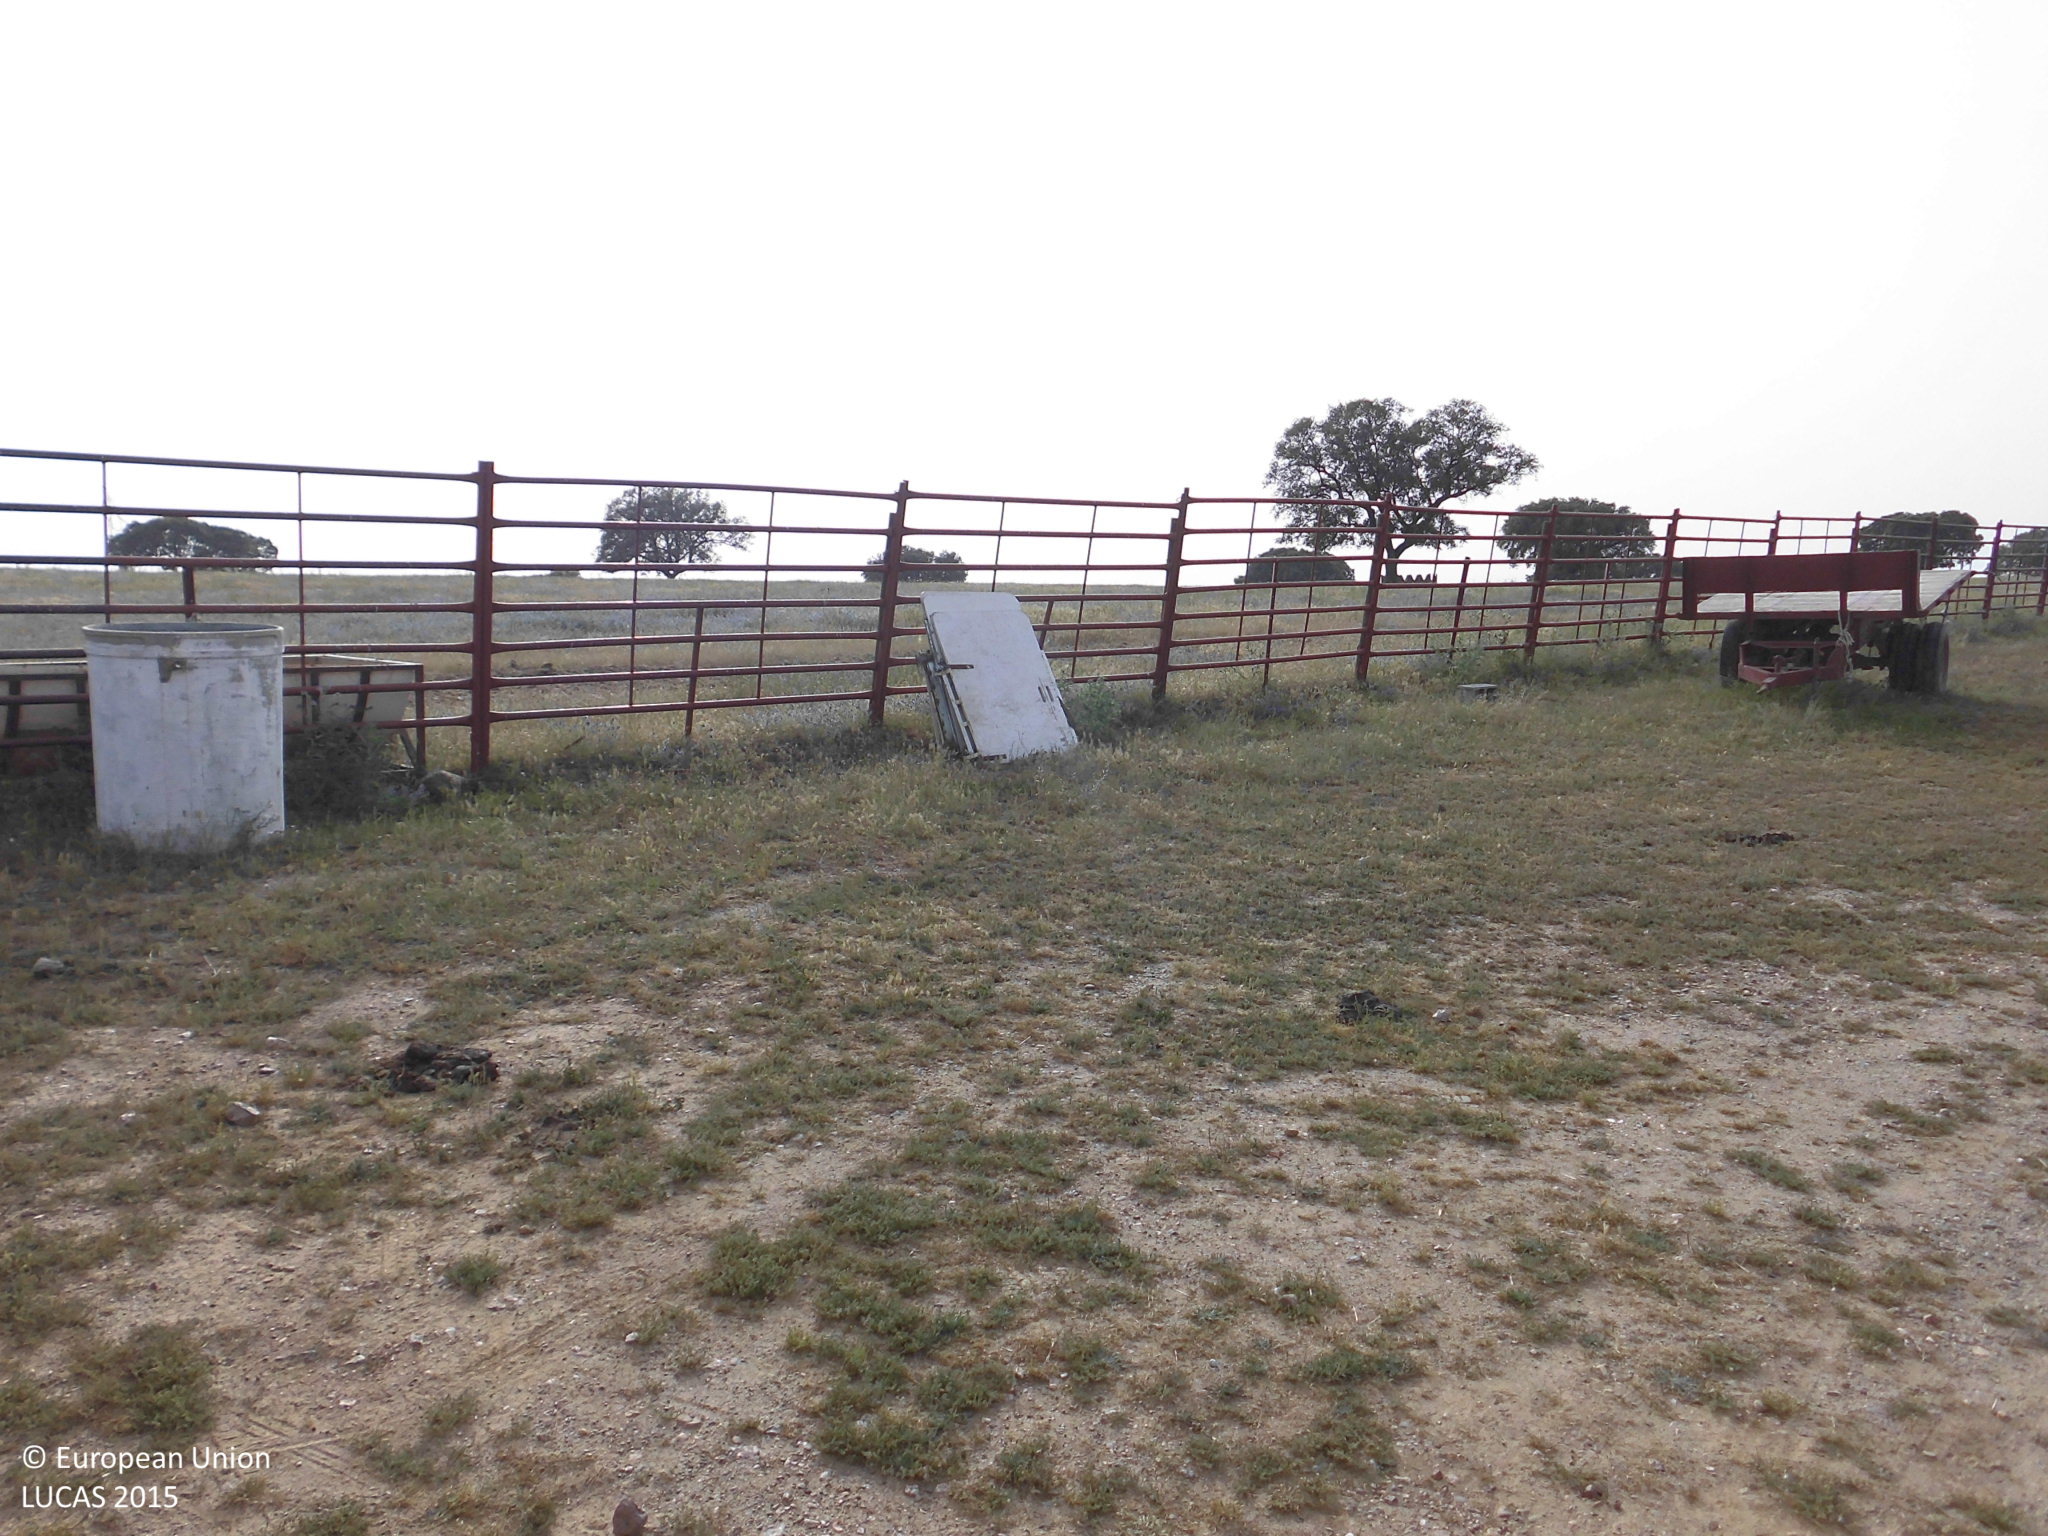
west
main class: Woodland
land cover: Broadleaved woodland
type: broadleaved evergreen forest
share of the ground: 10 - 25 %
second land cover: Grassland without tree/shrub cover
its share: > 75 %
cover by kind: shrubs 45 %, herbaceous plants 45 %, broadleaved forest trees 10 %
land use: Semi-natural and natural areas not in use
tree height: > 5 m
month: May
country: ES
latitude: 39.6046
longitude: -6.1256
